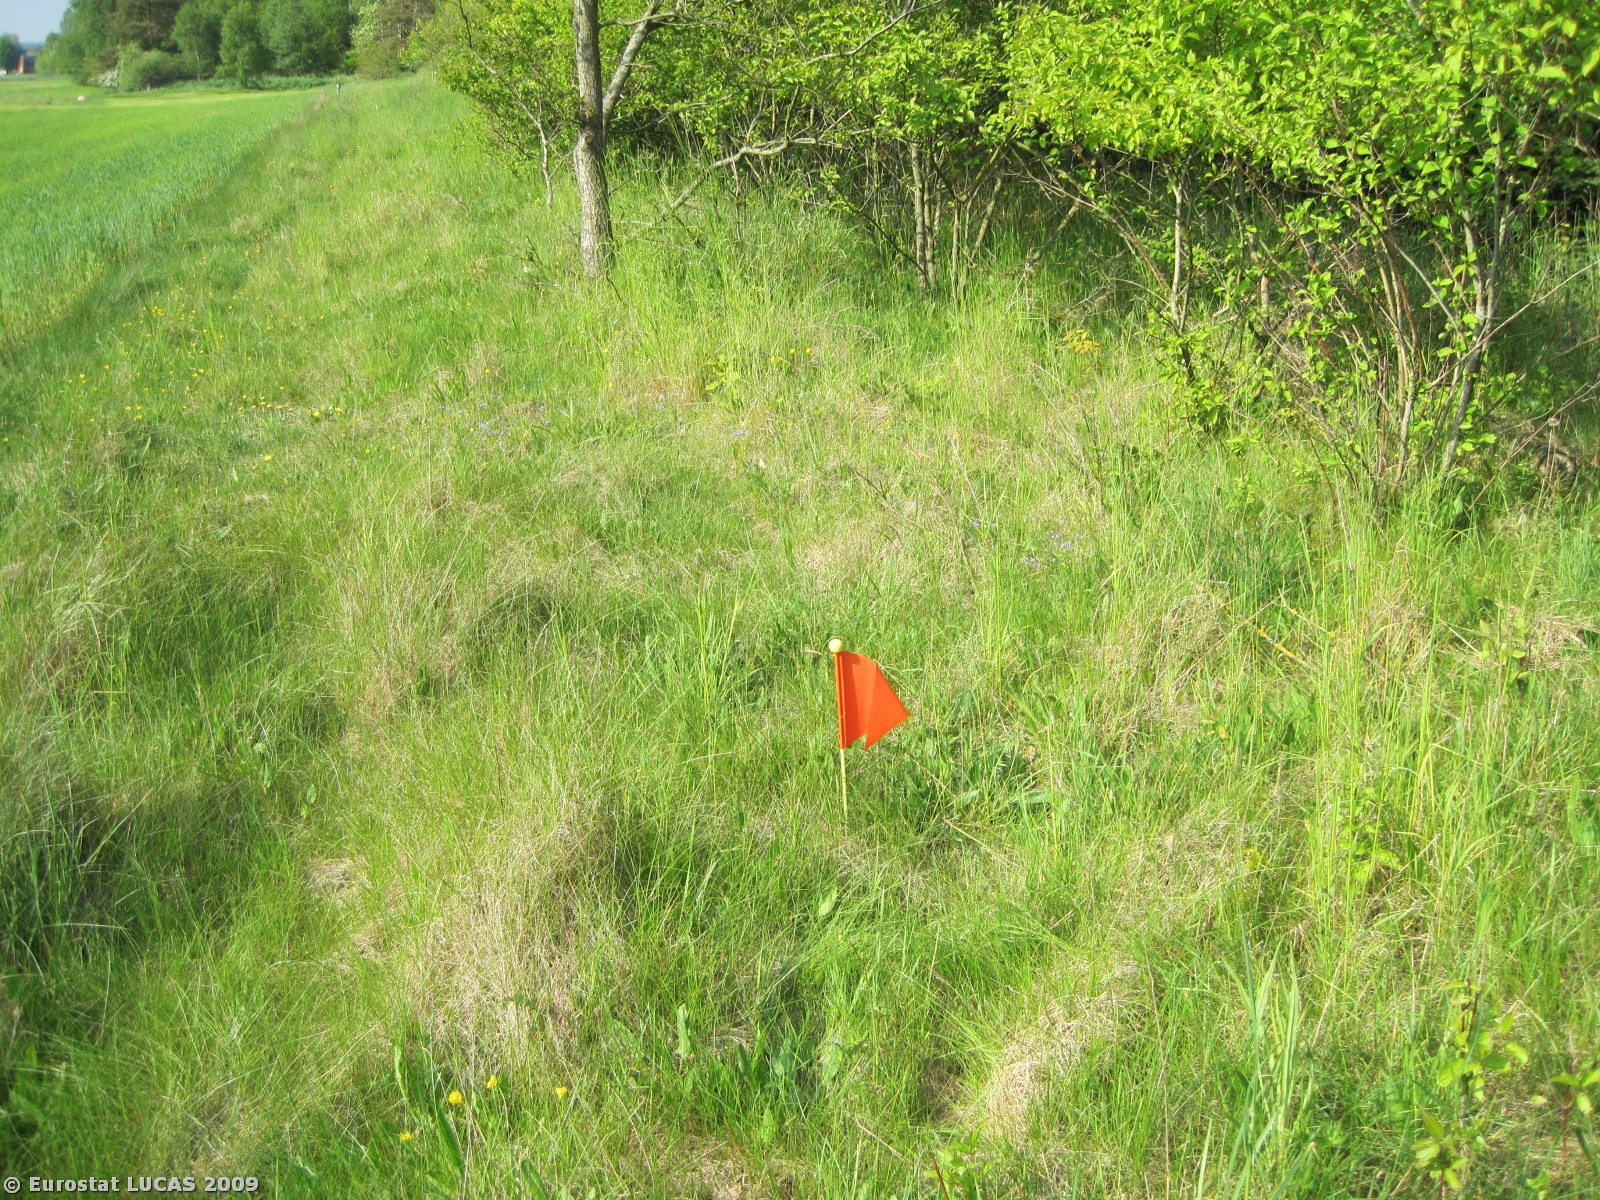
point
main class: Grassland
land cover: Grassland without tree/shrub cover
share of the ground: > 75 %
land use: Unused
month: May
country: DK
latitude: 56.6910
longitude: 10.1467
